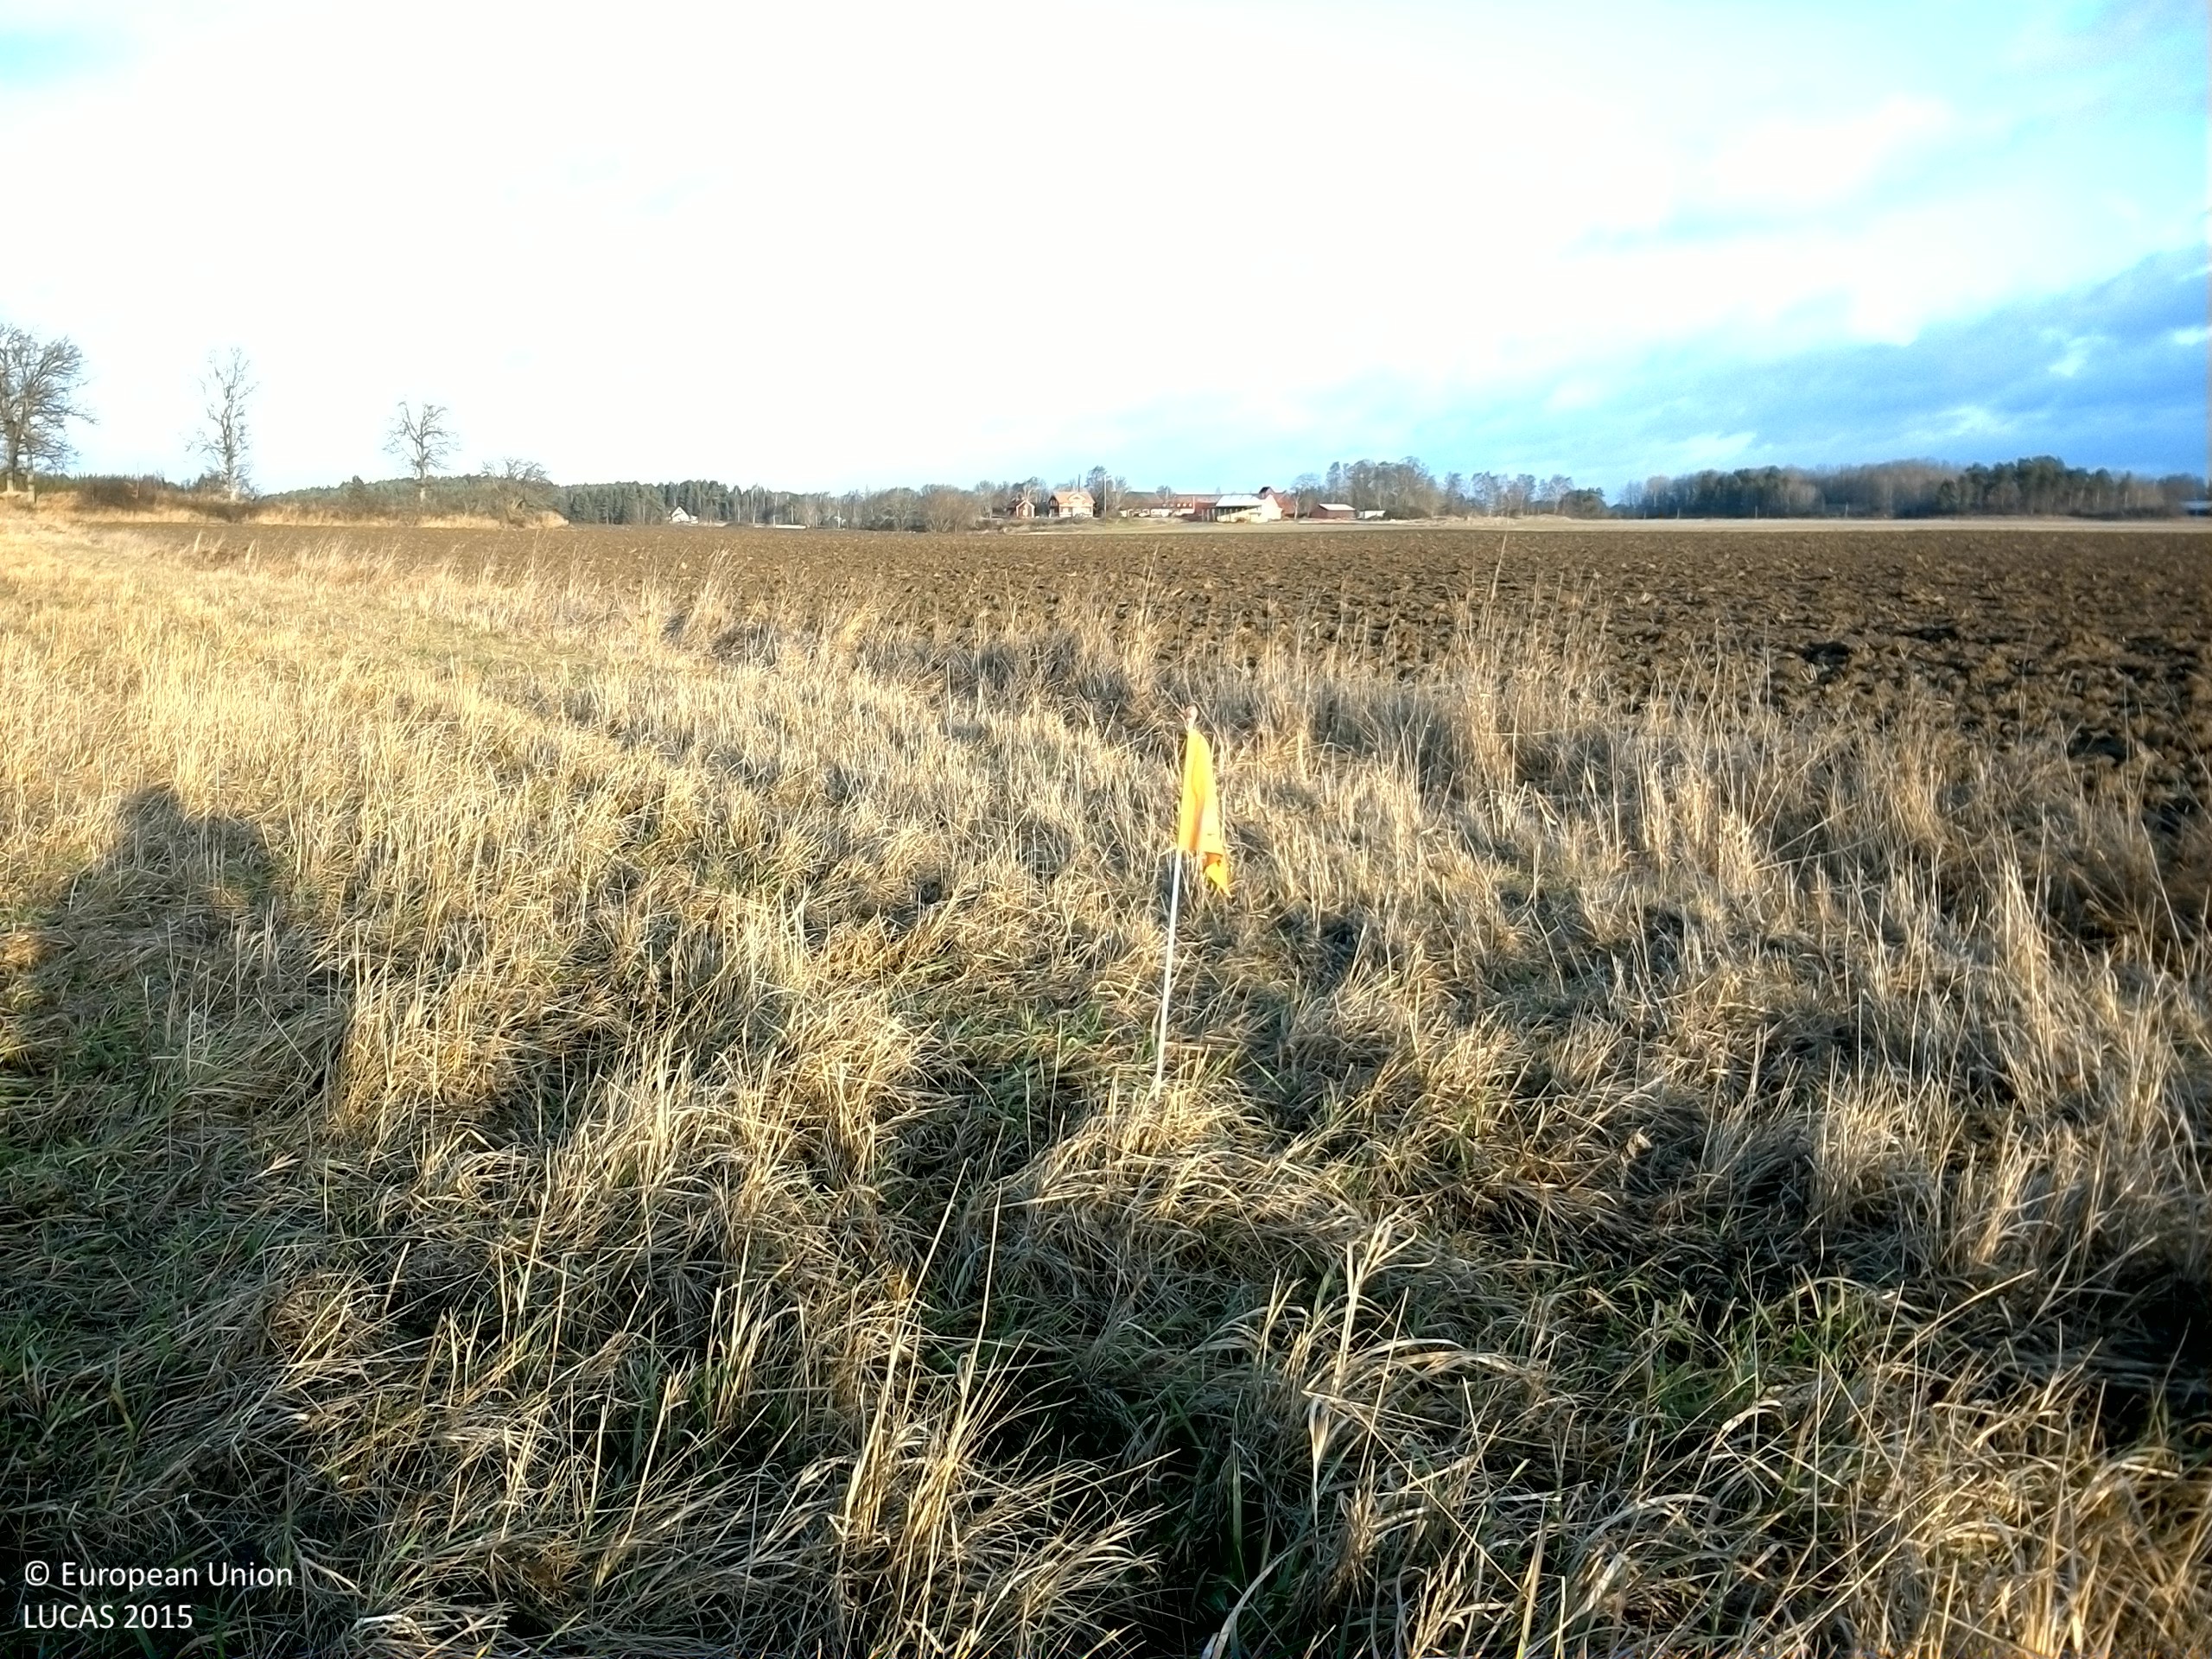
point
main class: Grassland
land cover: Grassland without tree/shrub cover
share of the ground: > 75 %
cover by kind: herbaceous plants 100 %
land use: Agriculture (excluding fallow land and kitchen gardens)
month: December
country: SE
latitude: 59.3786
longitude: 16.9112
